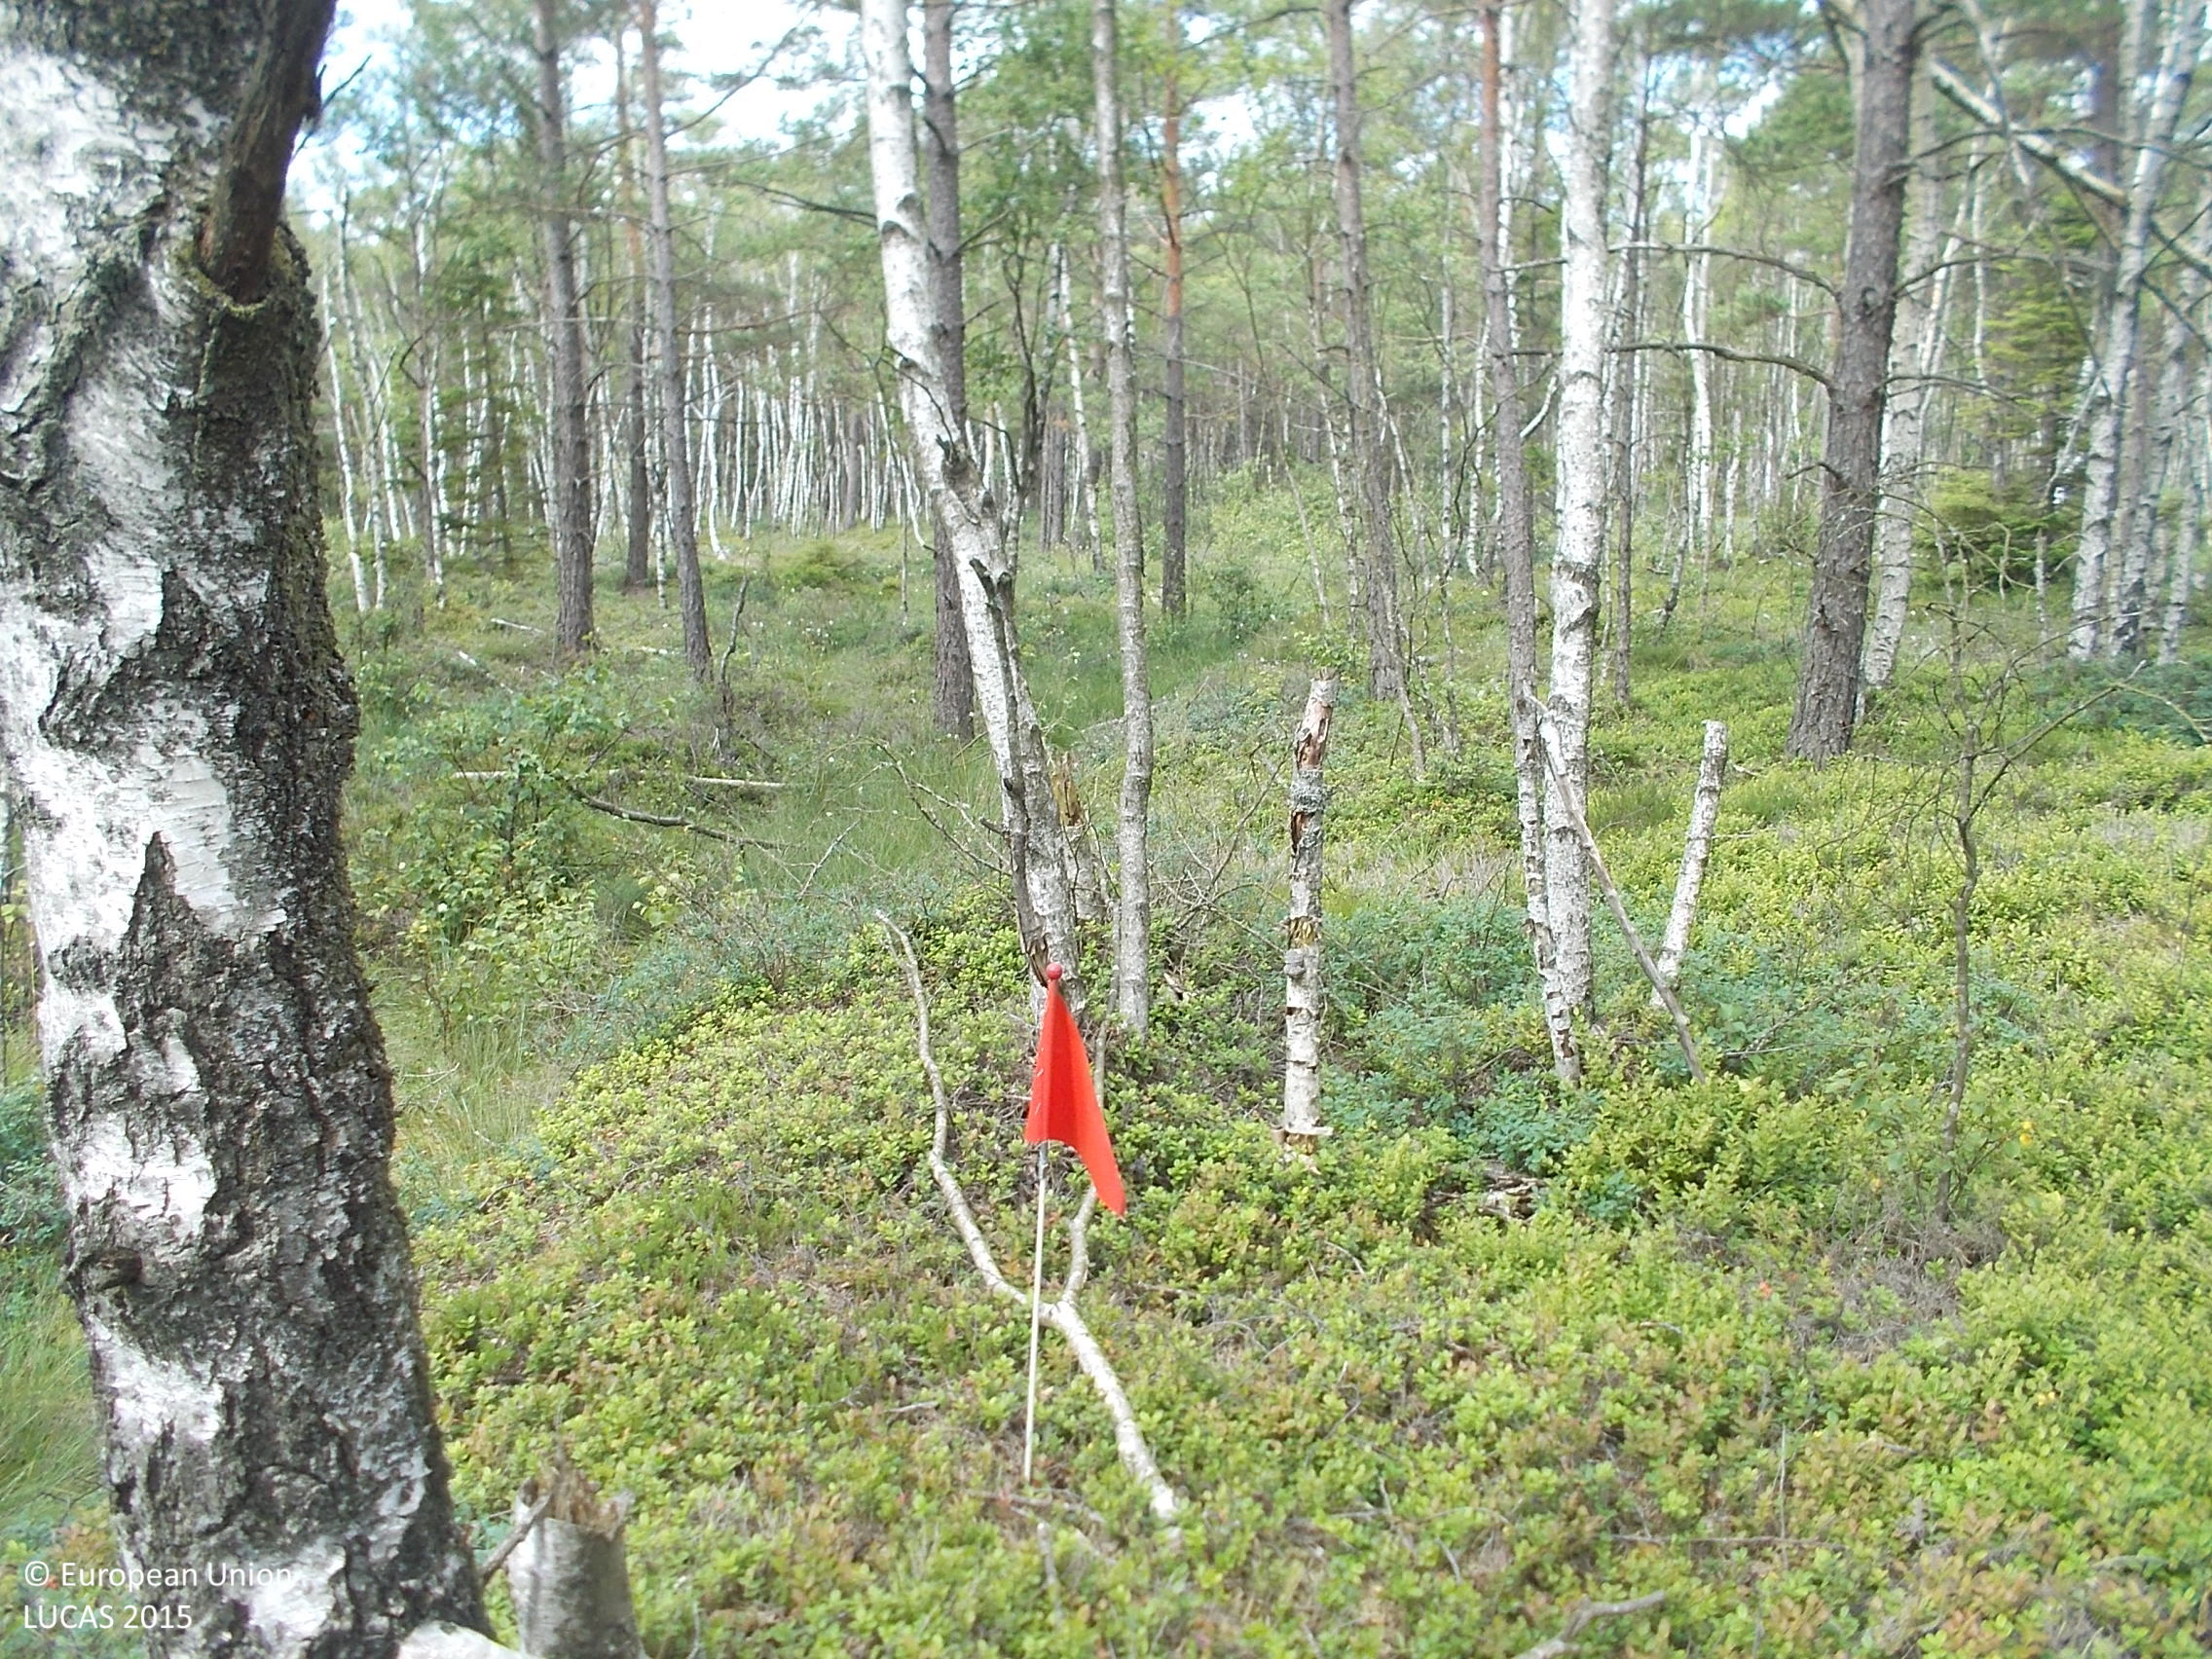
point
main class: Woodland
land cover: Pine dominated mixed woodland
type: boreal forest
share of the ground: 50 - 75 %
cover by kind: coniferous forest trees 40 %, broadleaved forest trees 35 %, shrubs 15 %, herbaceous plants 10 %
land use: Forestry
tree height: > 5 m
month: July
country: SE
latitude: 57.3912
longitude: 12.2427
